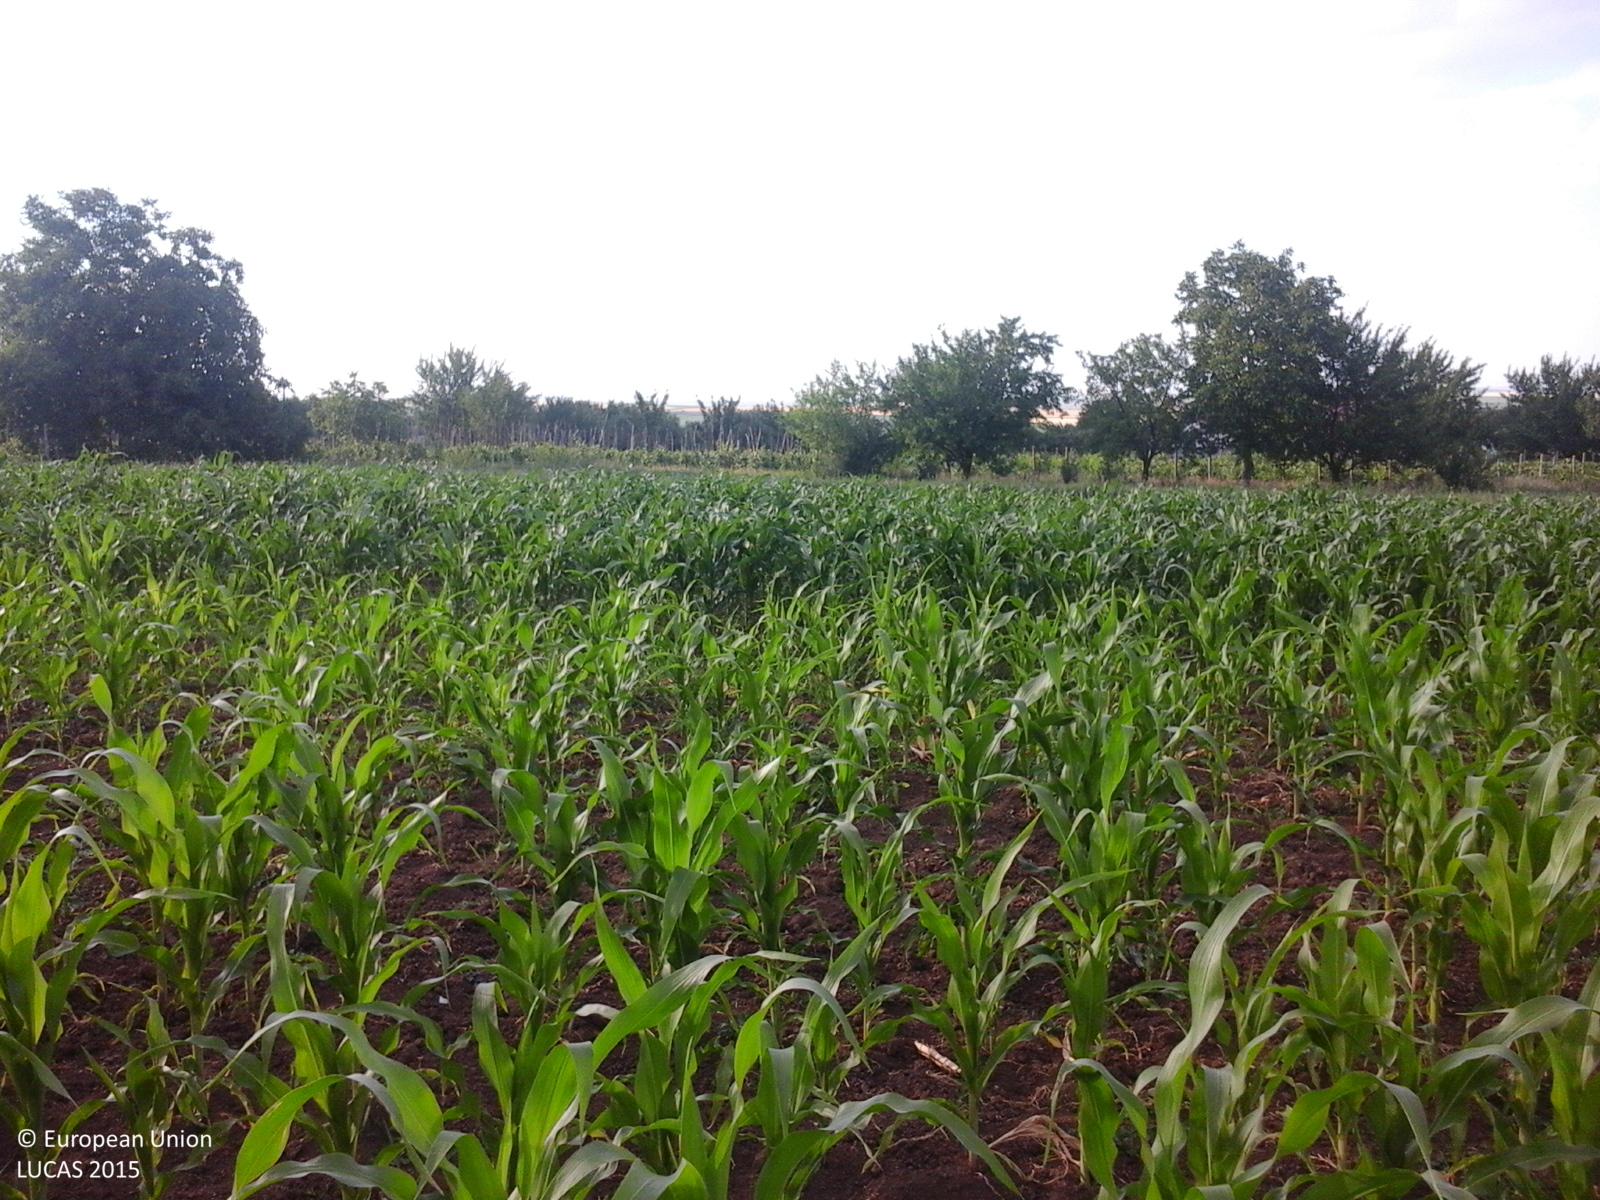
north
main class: Cropland
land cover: Maize
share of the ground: 50 - 75 %
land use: Agriculture (excluding fallow land and kitchen gardens)
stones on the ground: < 10 %
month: June
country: RO
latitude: 47.1511
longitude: 27.3210
